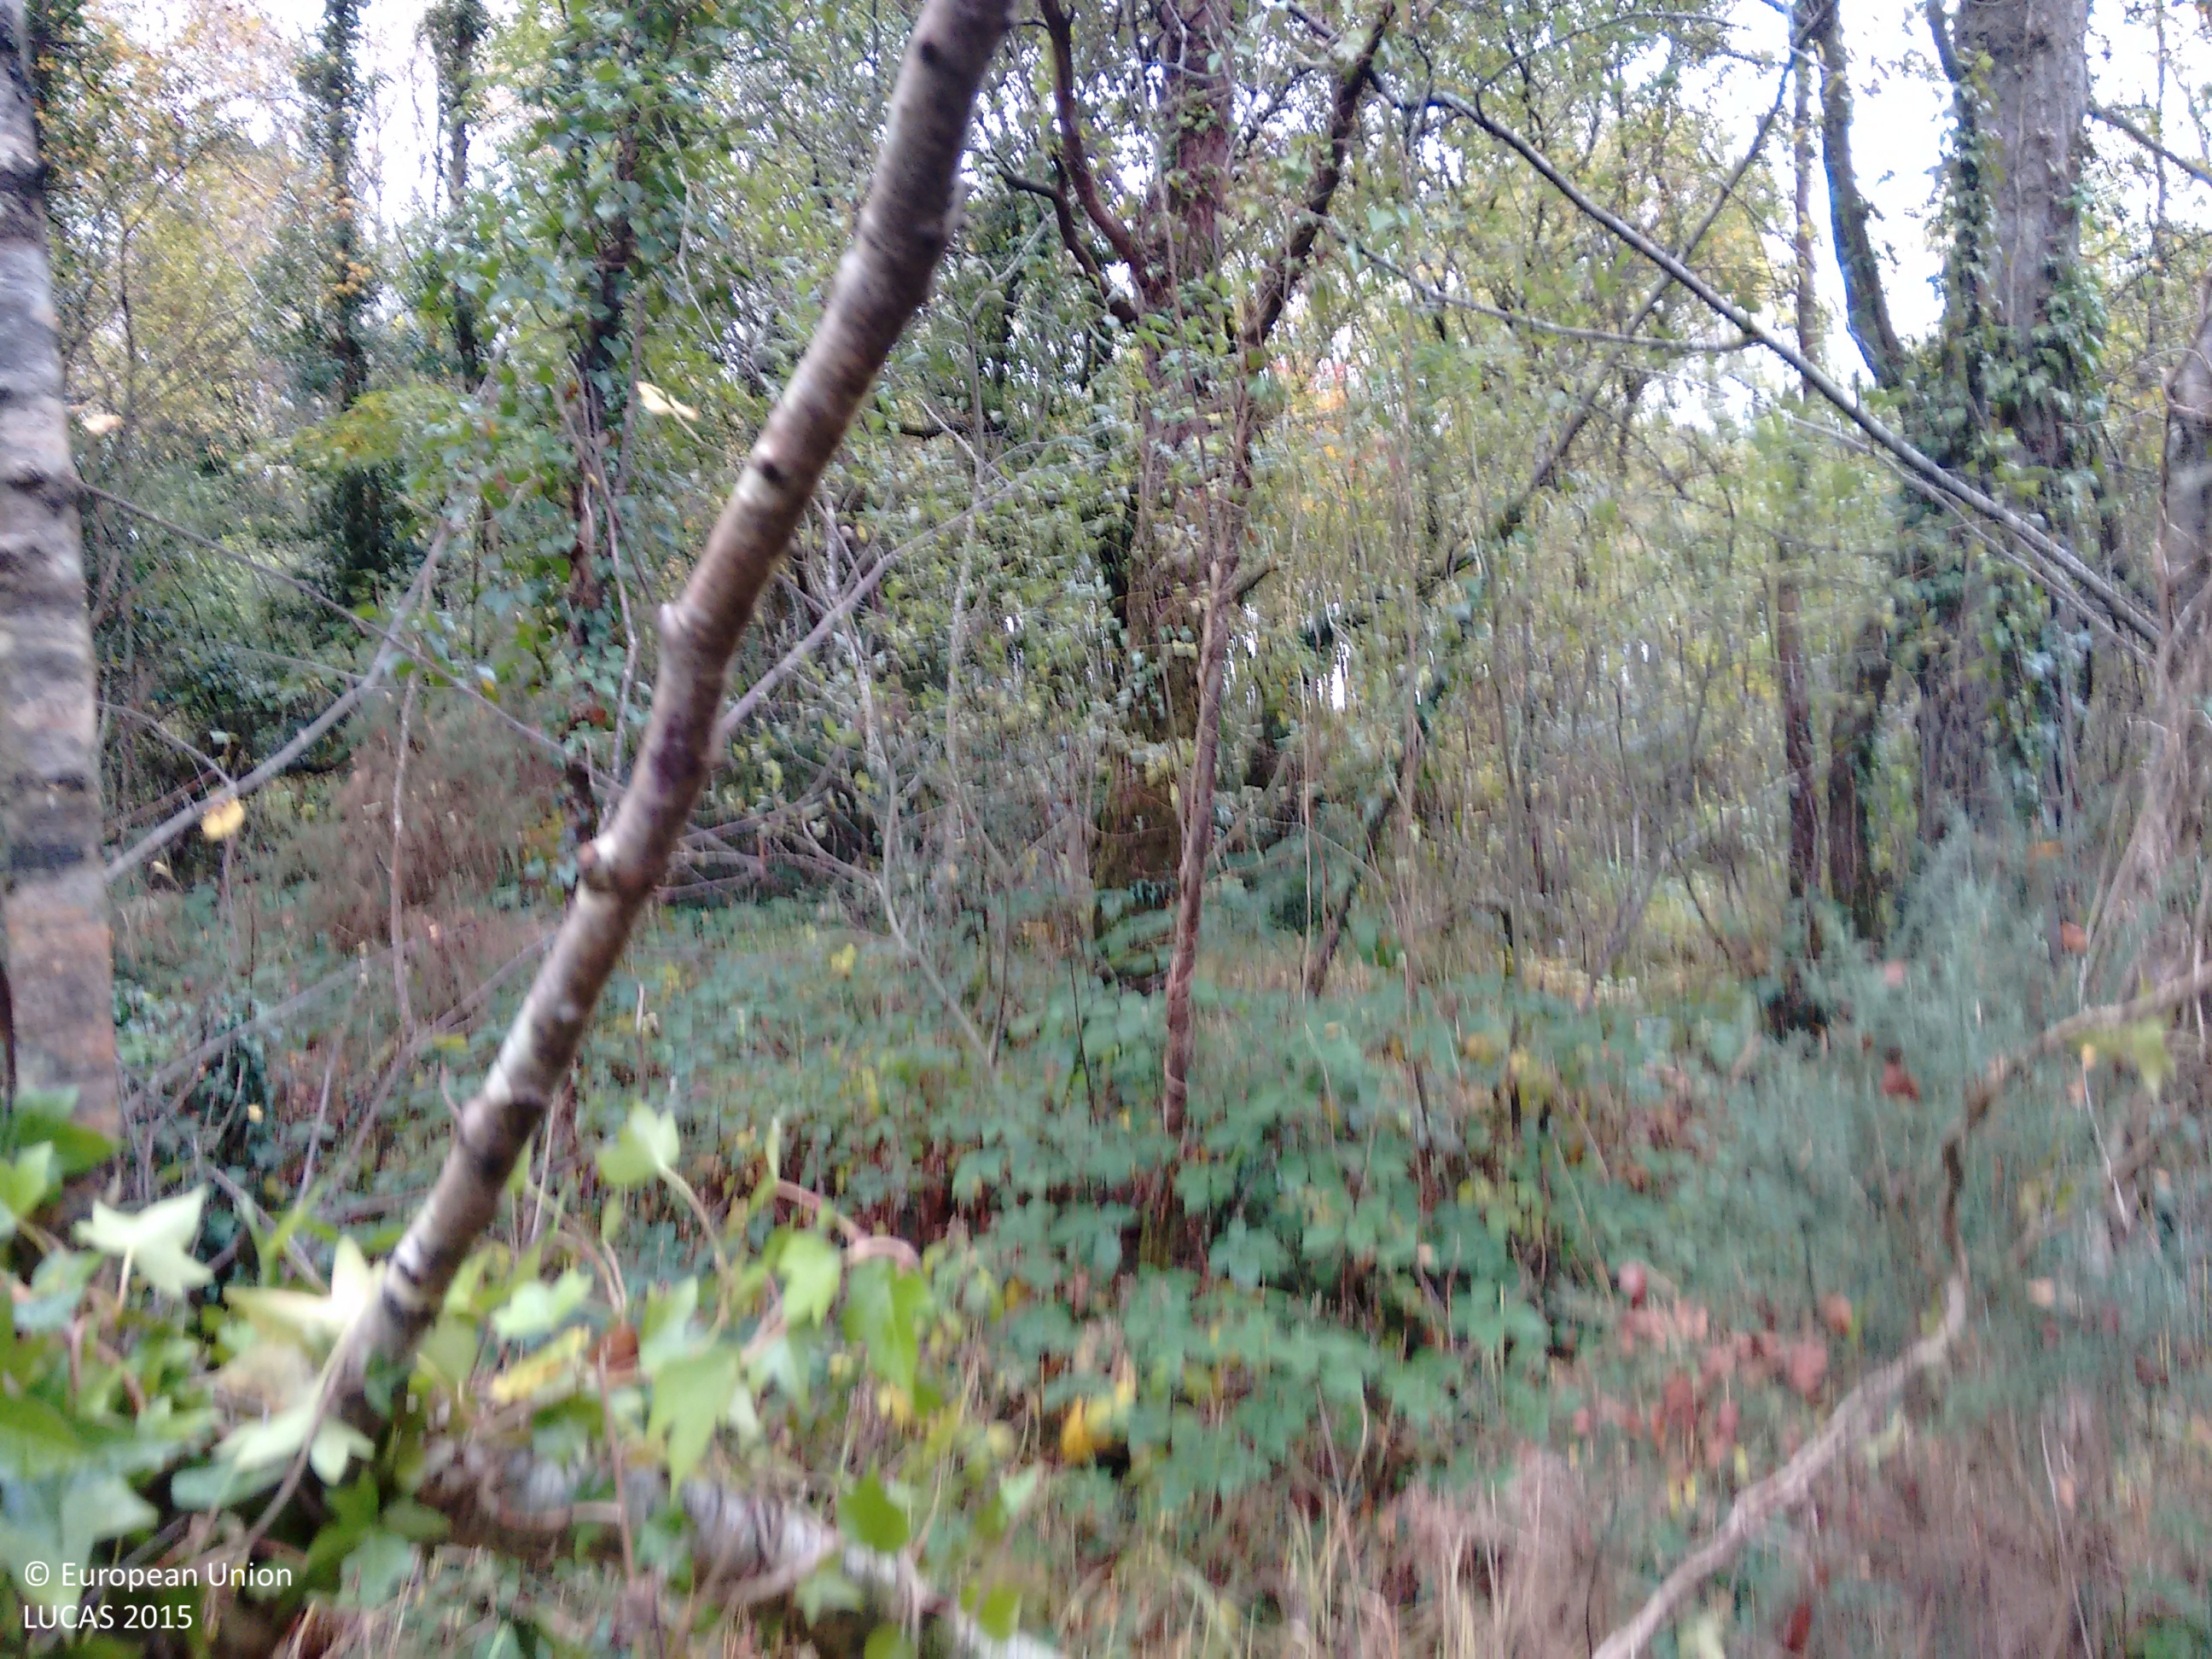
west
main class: Woodland
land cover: Other mixed woodland
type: acidophilous oak and oak-birch forest
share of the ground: > 75 %
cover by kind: broadleaved forest trees 60 %, coniferous forest trees 40 %
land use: Semi-natural and natural areas not in use
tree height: > 5 m
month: October
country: IE
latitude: 53.2248
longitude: -7.5812
